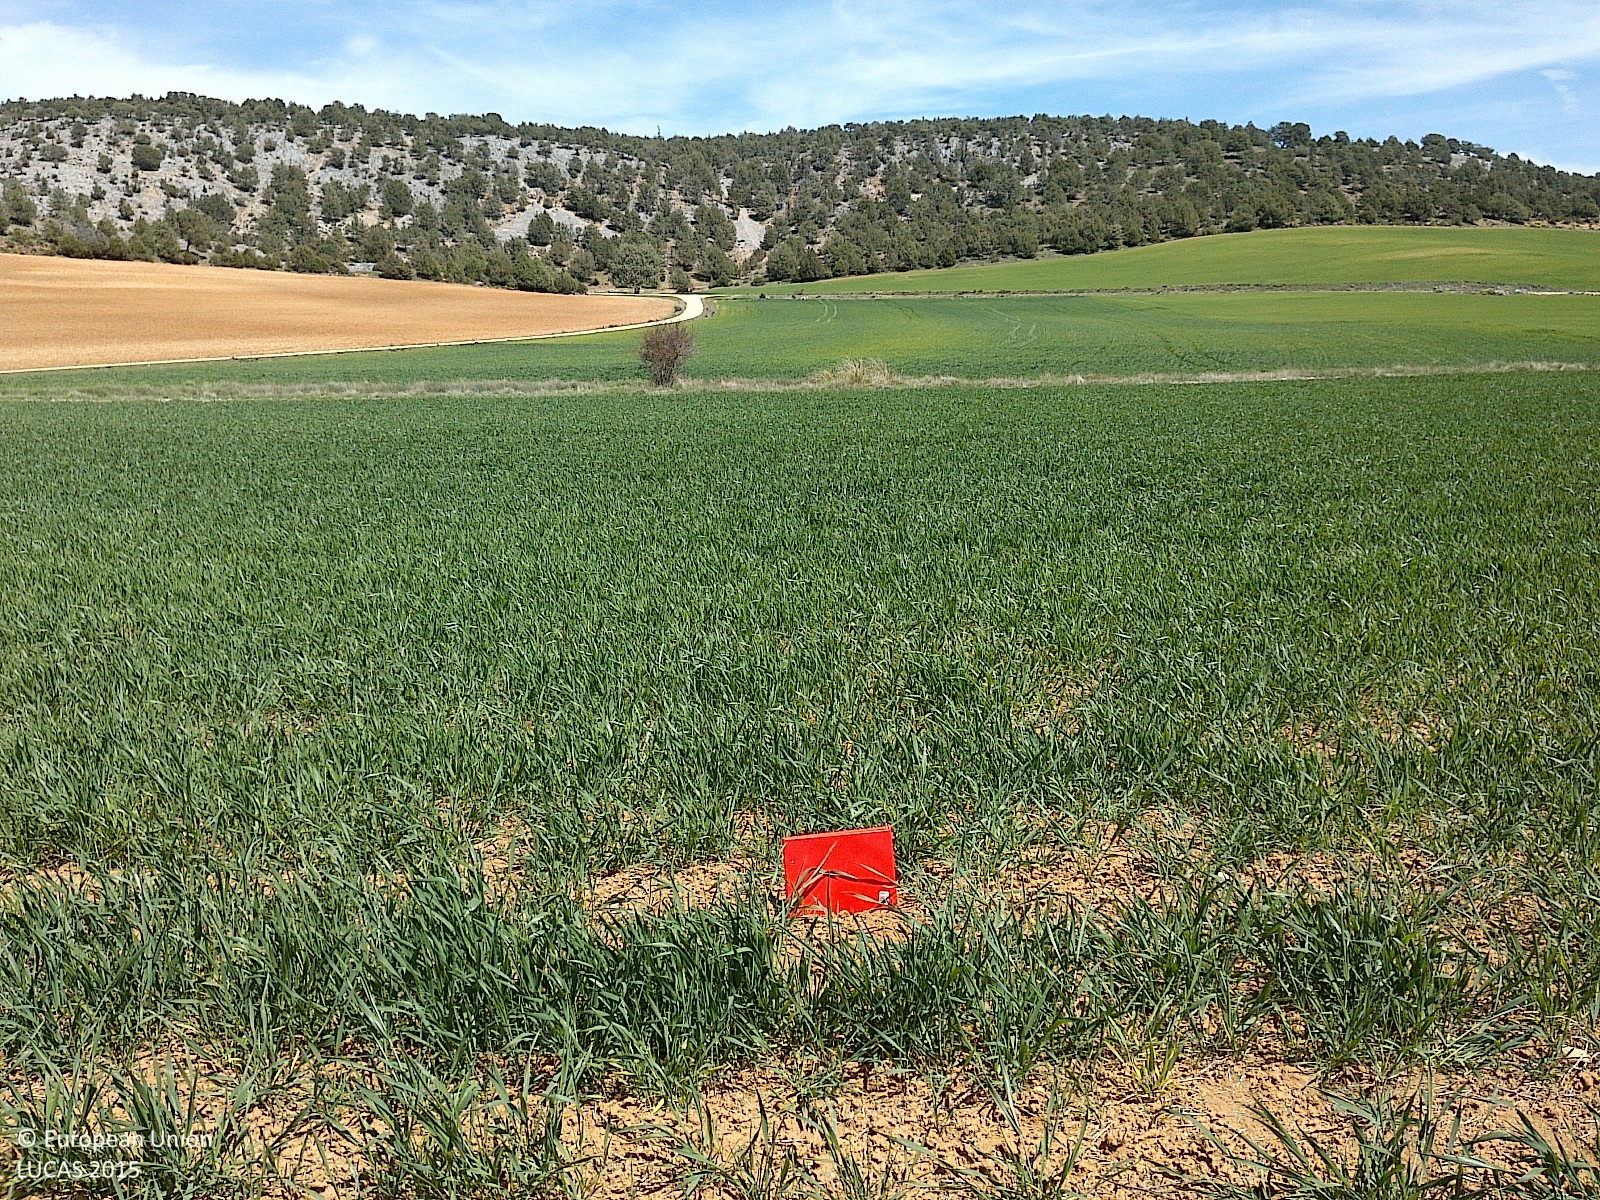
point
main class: Cropland
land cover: Barley
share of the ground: 50 - 75 %
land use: Agriculture (excluding fallow land and kitchen gardens)
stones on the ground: < 10 %
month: April
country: ES
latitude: 41.7829
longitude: -3.2226
